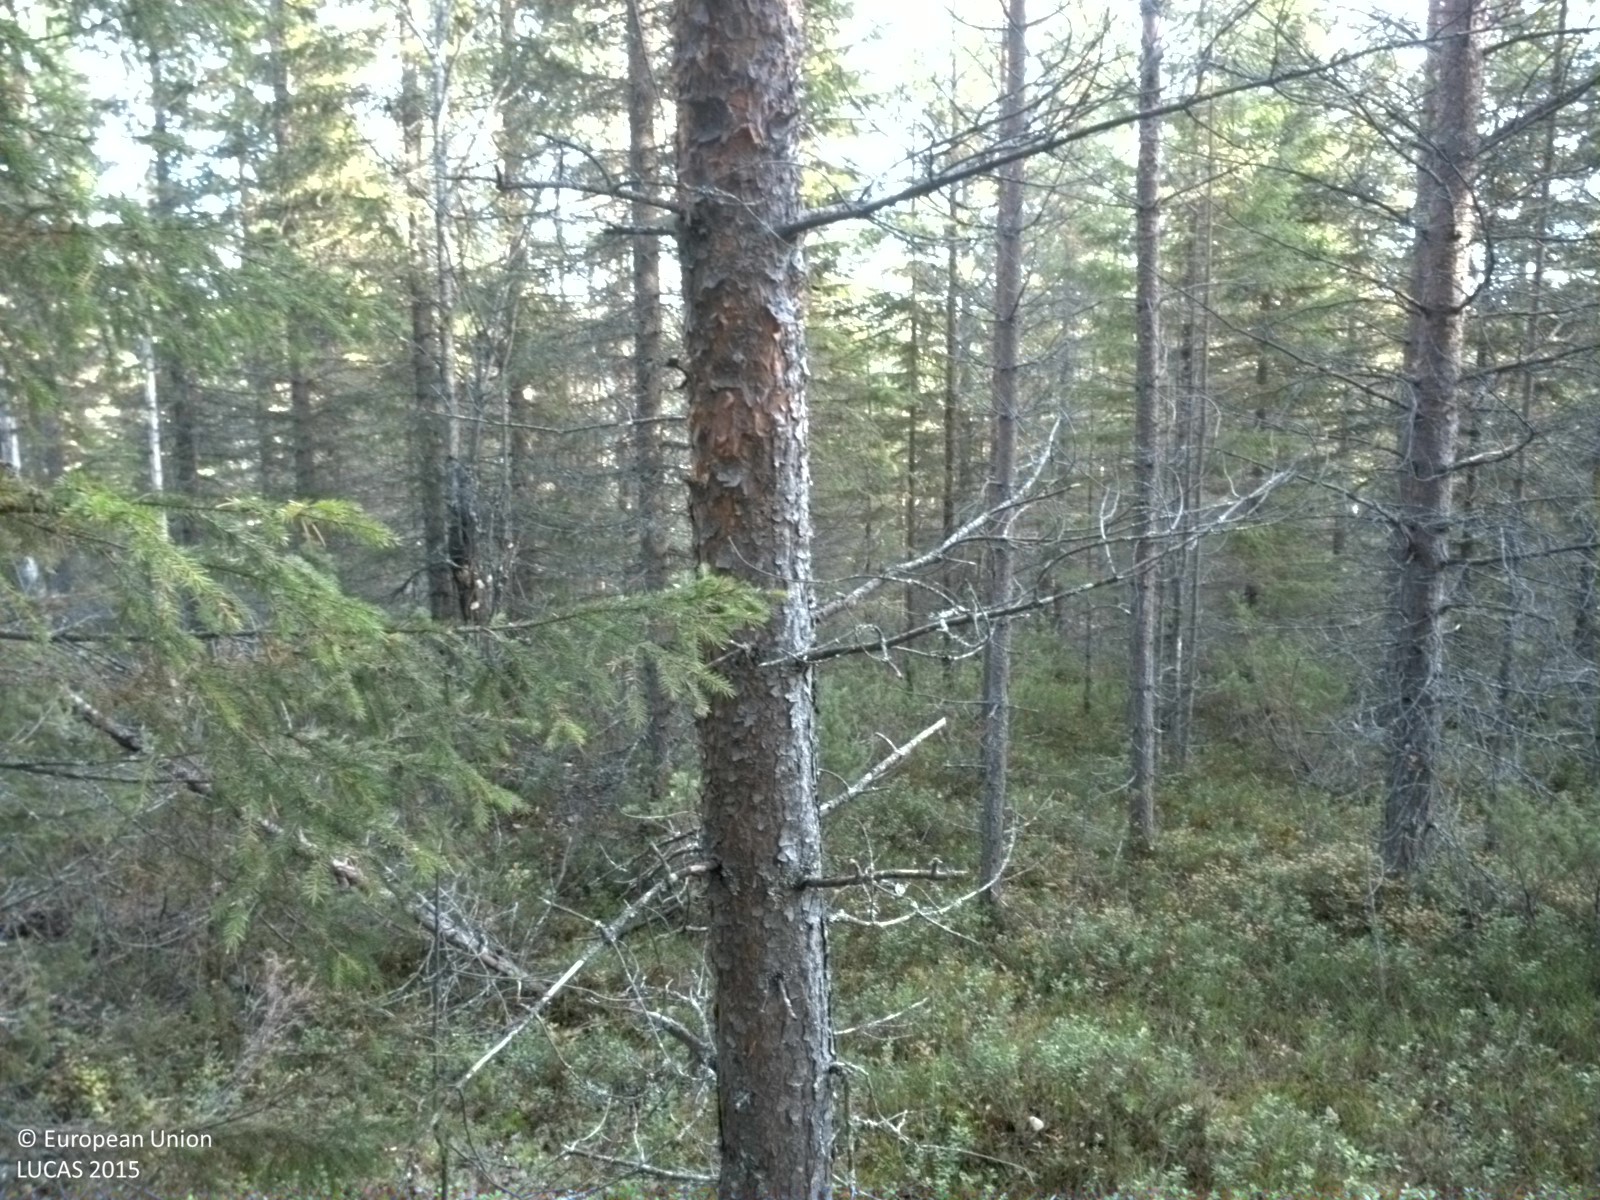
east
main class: Woodland
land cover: Pine dominated coniferous woodland
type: boreal forest
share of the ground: 25 - 50 %
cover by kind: shrubs 60 %, coniferous forest trees 35 %, lichens and mosses 5 %
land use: Forestry
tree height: > 5 m
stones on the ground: 25 - 50 %
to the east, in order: Pine dominated coniferous woodland; Other mixed woodland; Spruce dominated coniferous woodland; Spruce dominated mixed woodland; Broadleaved woodland; Ditches and canals; Paved roads, cycling and walking lanes; Ditches and canals; Broadleaved woodland; Spruce dominated coniferous woodland
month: October
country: SE
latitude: 65.9418
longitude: 20.8904
